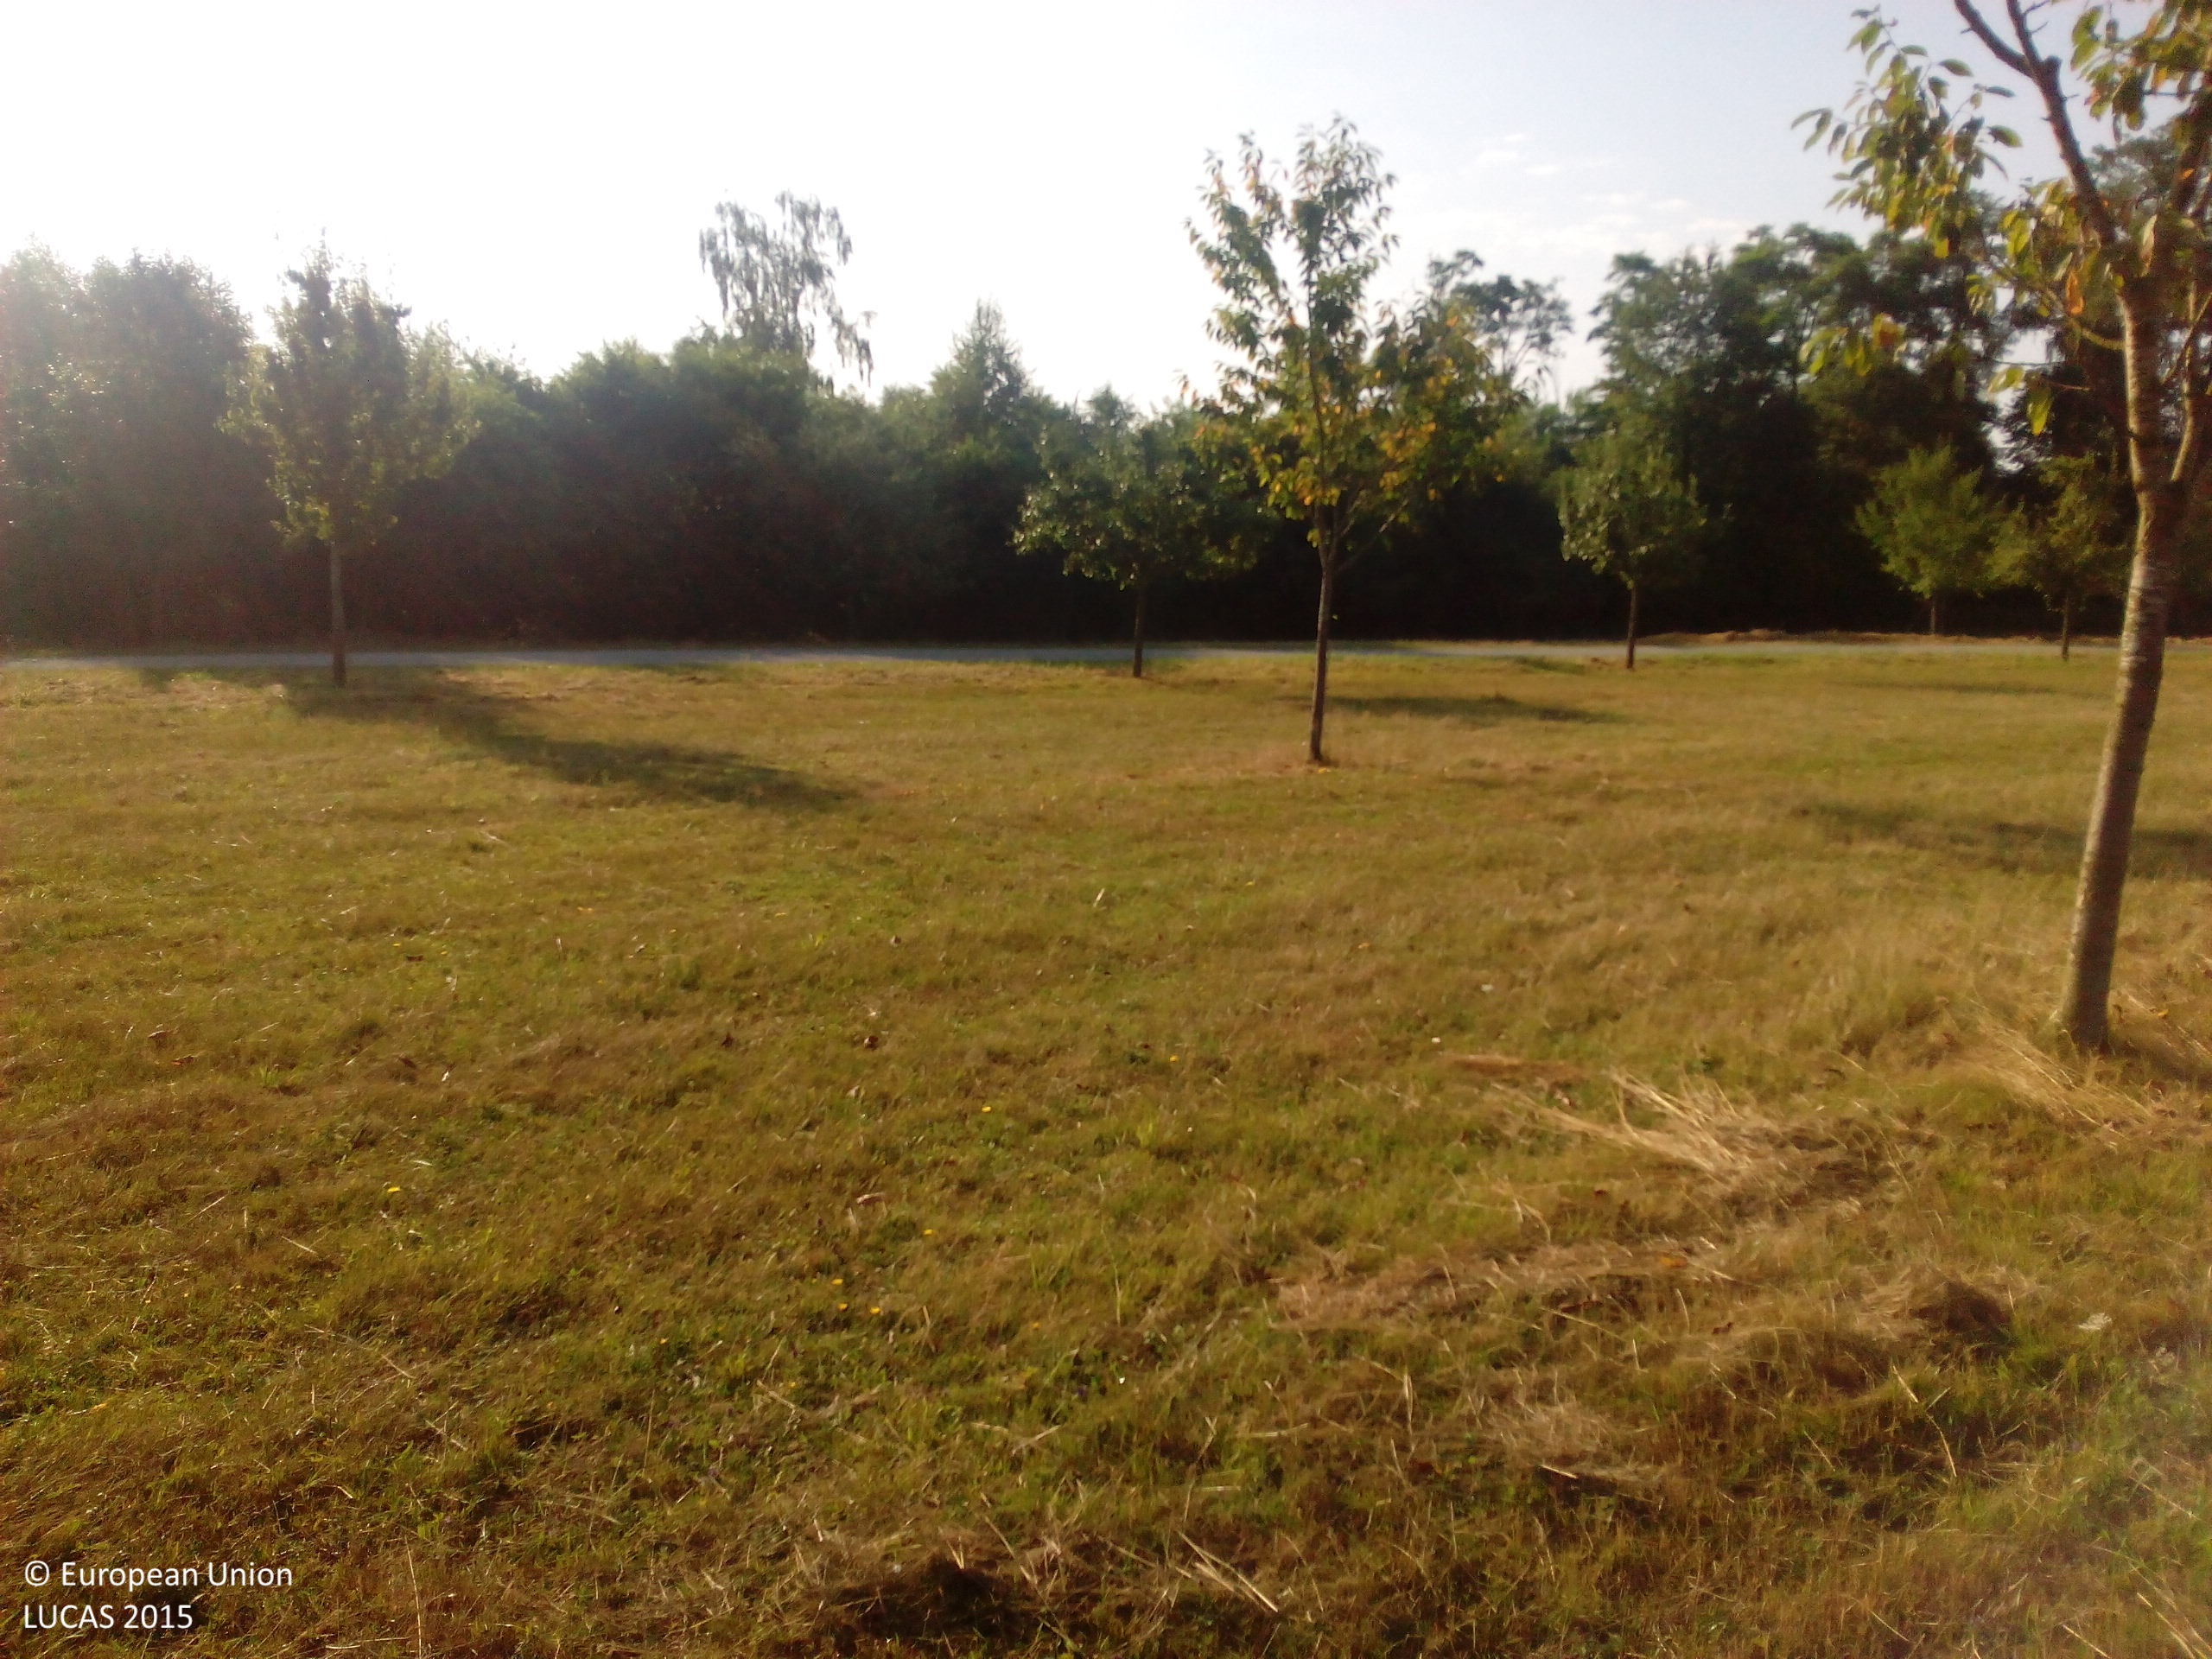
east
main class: Cropland
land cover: Pear fruit
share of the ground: < 10 %
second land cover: Grassland without tree/shrub cover
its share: > 75 %
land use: Agriculture (excluding fallow land and kitchen gardens)
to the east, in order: Pear fruit; Grassland without tree/shrub cover; Apple fruit; Tracks; Grassland with sparse tree/shrub cover; Broadleaved woodland; Grassland without tree/shrub cover; Maize; Grass margins; Tracks; Grassland without tree/shrub cover; Paved roads, cycling and walking lanes; Grass margins; Barley
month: July
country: DE
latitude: 48.3721
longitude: 13.3068
